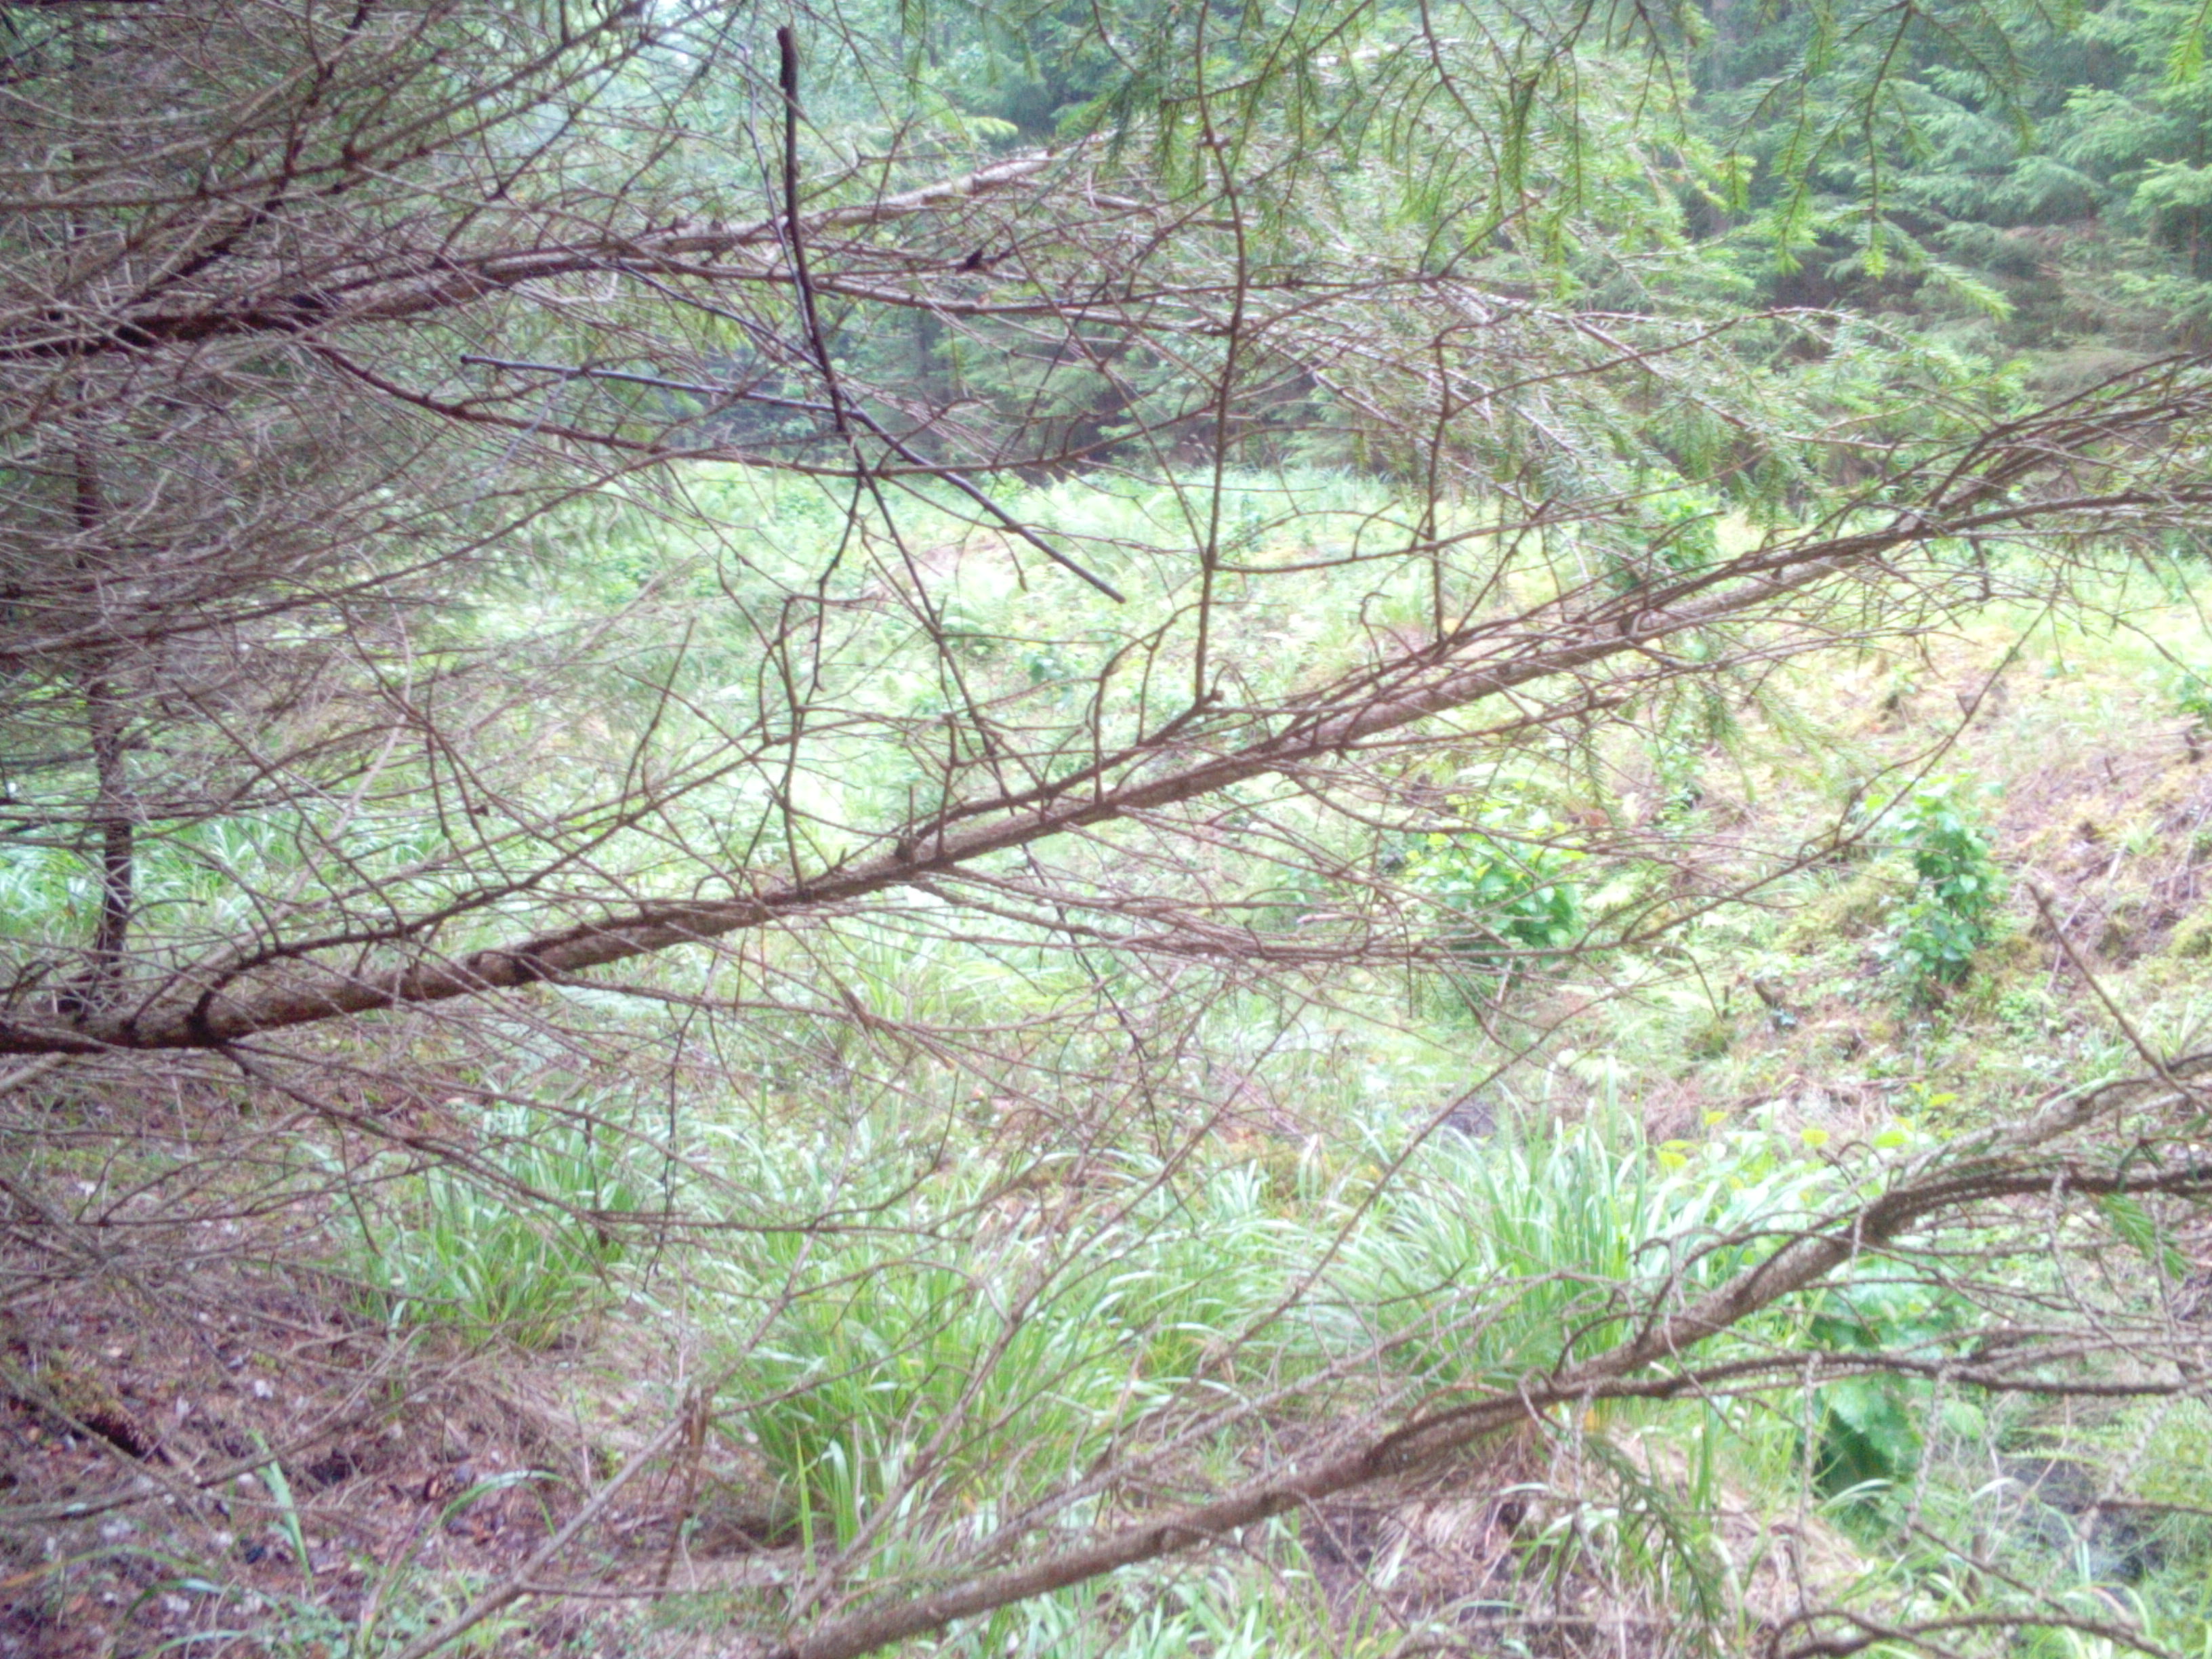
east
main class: Woodland
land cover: Spruce dominated mixed woodland
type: hemiboreal forest and nemoral coniferous forest and mixed broadleaved-coniferous forest
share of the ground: > 75 %
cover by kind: coniferous forest trees 50 %, broadleaved forest trees 25 %, herbaceous plants 25 %
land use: Forestry
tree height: > 5 m
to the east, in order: Spruce dominated mixed woodland; Spontaneously vegetated surfaces; Ditches and canals; Other mixed woodland; Spruce dominated mixed woodland; Grass margins; Paved roads, cycling and walking lanes; Ditches and canals; Broadleaved woodland
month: July
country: LV
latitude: 57.0011
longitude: 22.0497
